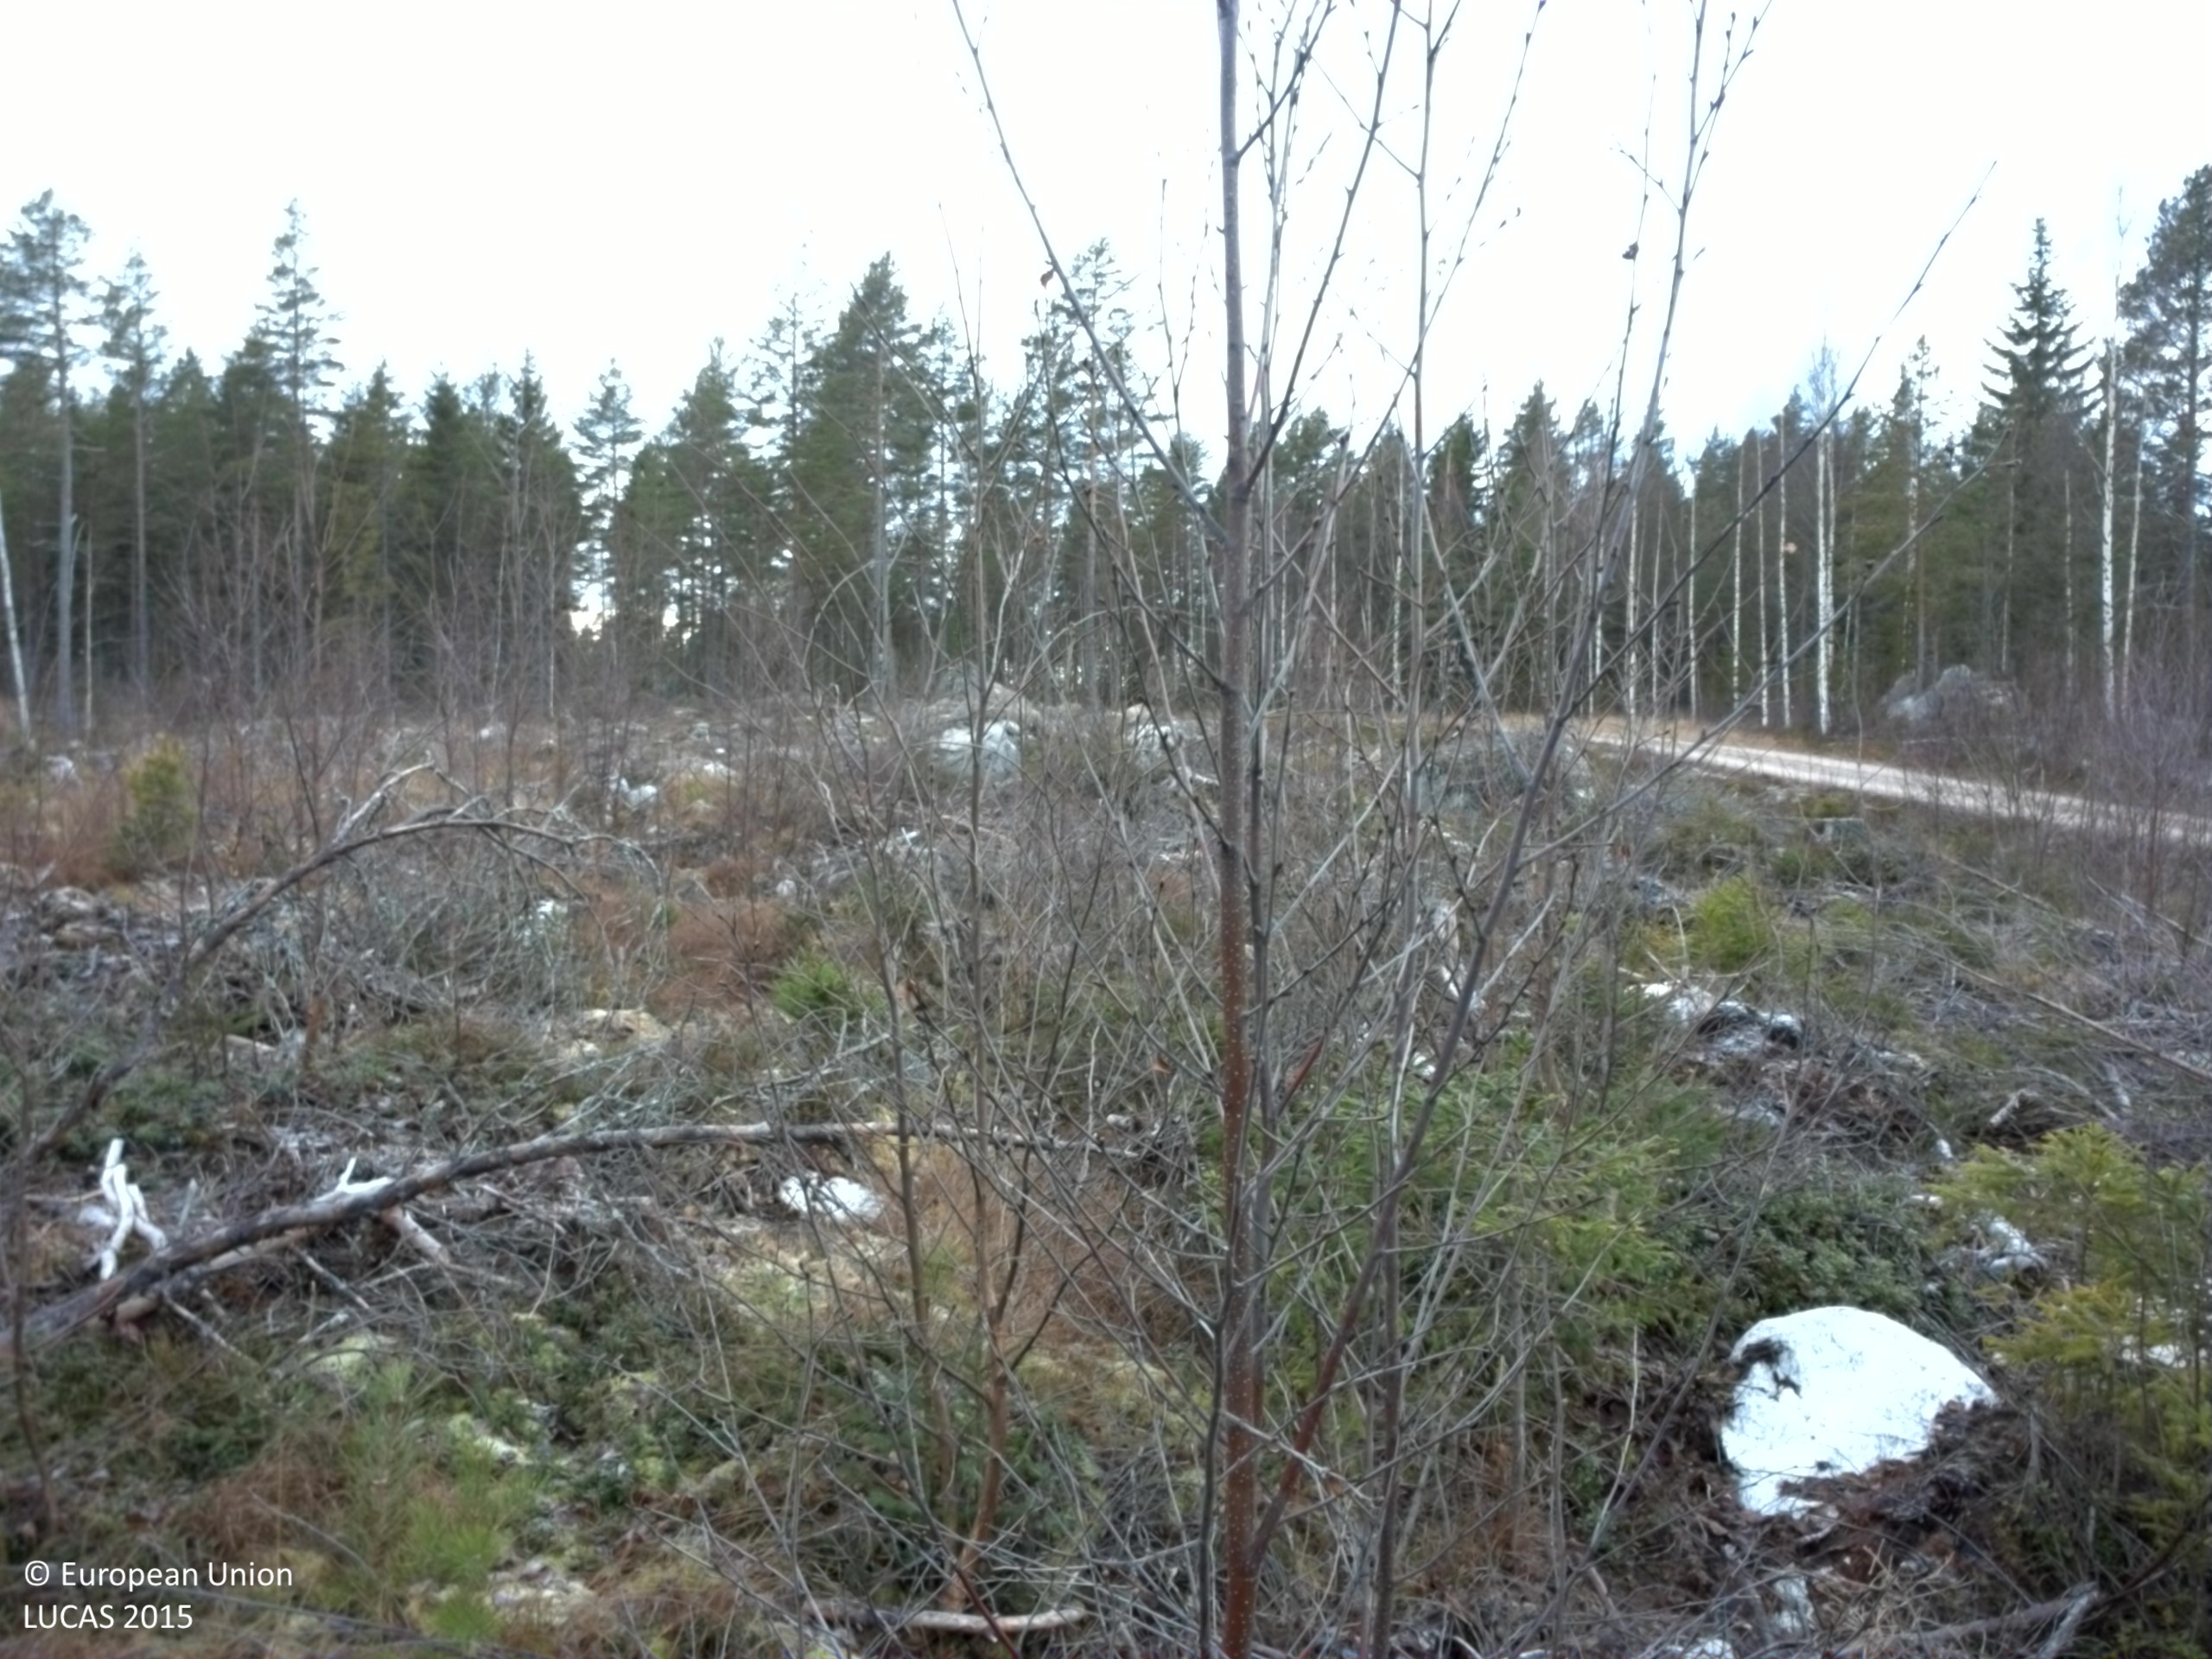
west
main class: Woodland
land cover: Spruce dominated mixed woodland
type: boreal forest
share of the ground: 10 - 25 %
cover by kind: shrubs 30 %, unconsolidated bare surface 20 %, lichens and mosses 15 %, broadleaved forest trees 10 %, herbaceous plants 10 %, consolidated bare surface 10 %, coniferous forest trees 5 %
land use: Forestry
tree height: < 5 m
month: December
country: SE
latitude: 61.3276
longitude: 16.9919
